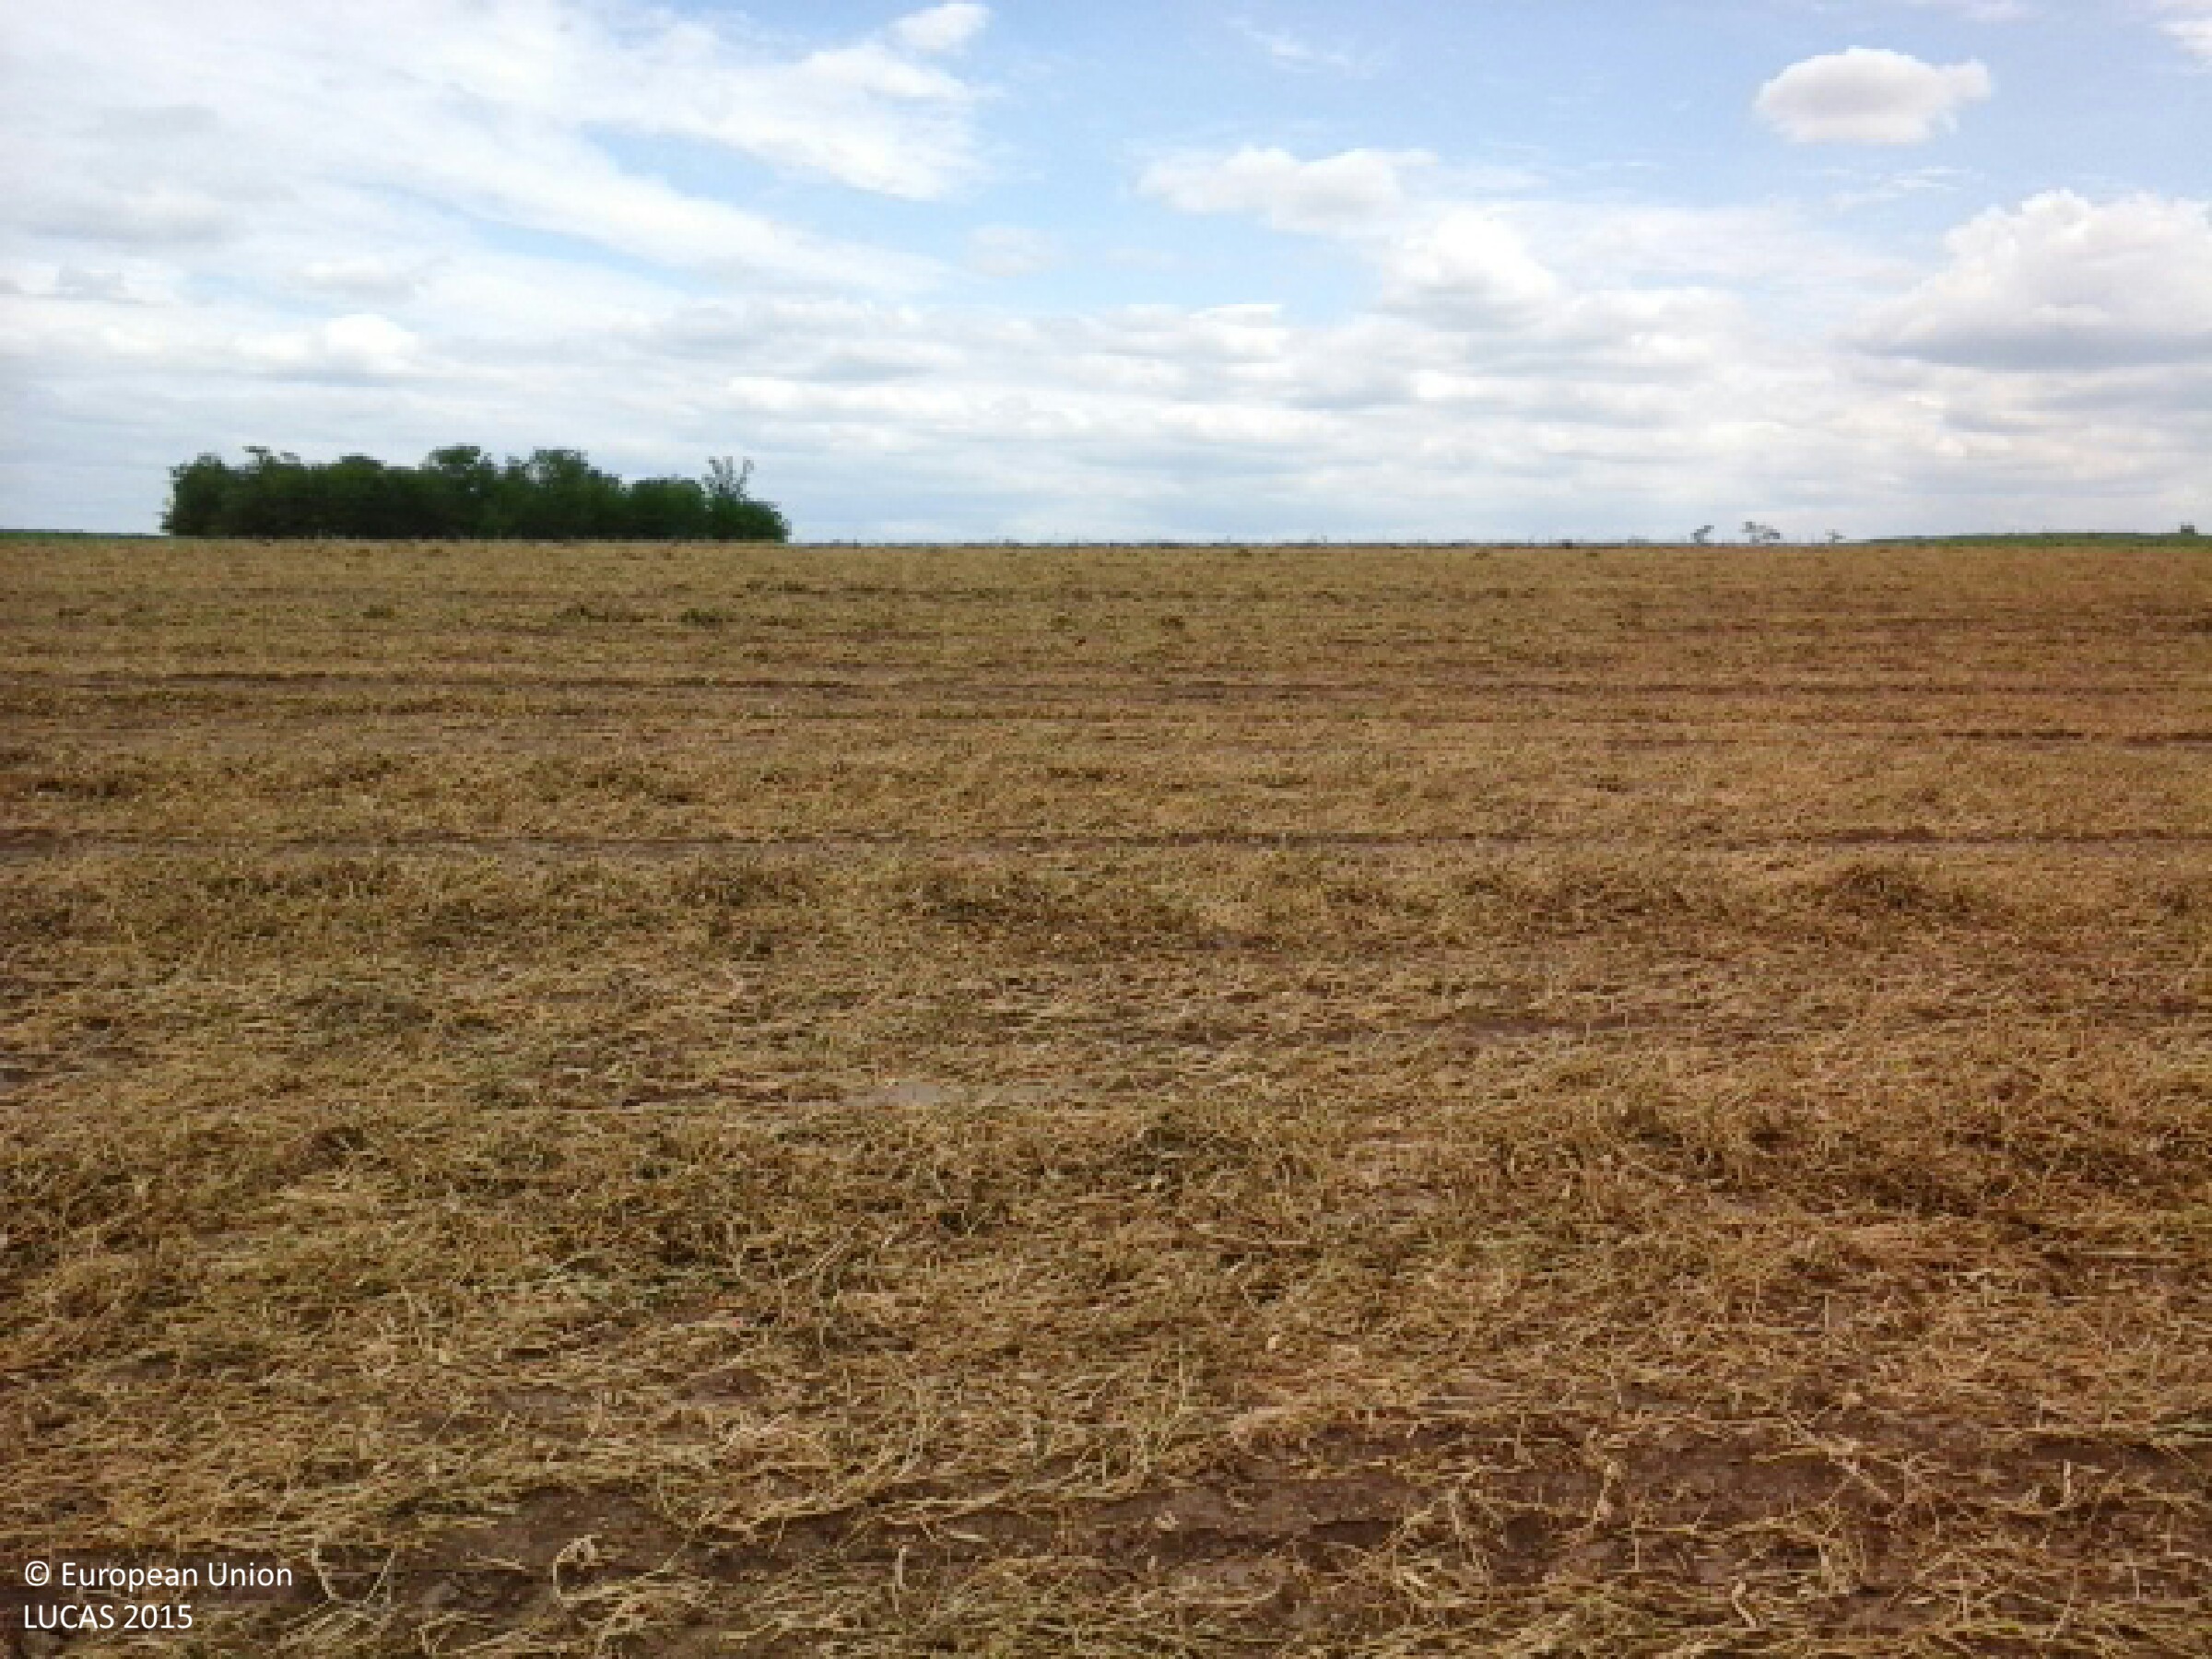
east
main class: Cropland
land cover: Dry pulses
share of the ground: < 10 %
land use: Agriculture (excluding fallow land and kitchen gardens)
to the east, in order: Dry pulses; Maize; Triticale
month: June
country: HU
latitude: 47.9652
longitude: 21.4965
